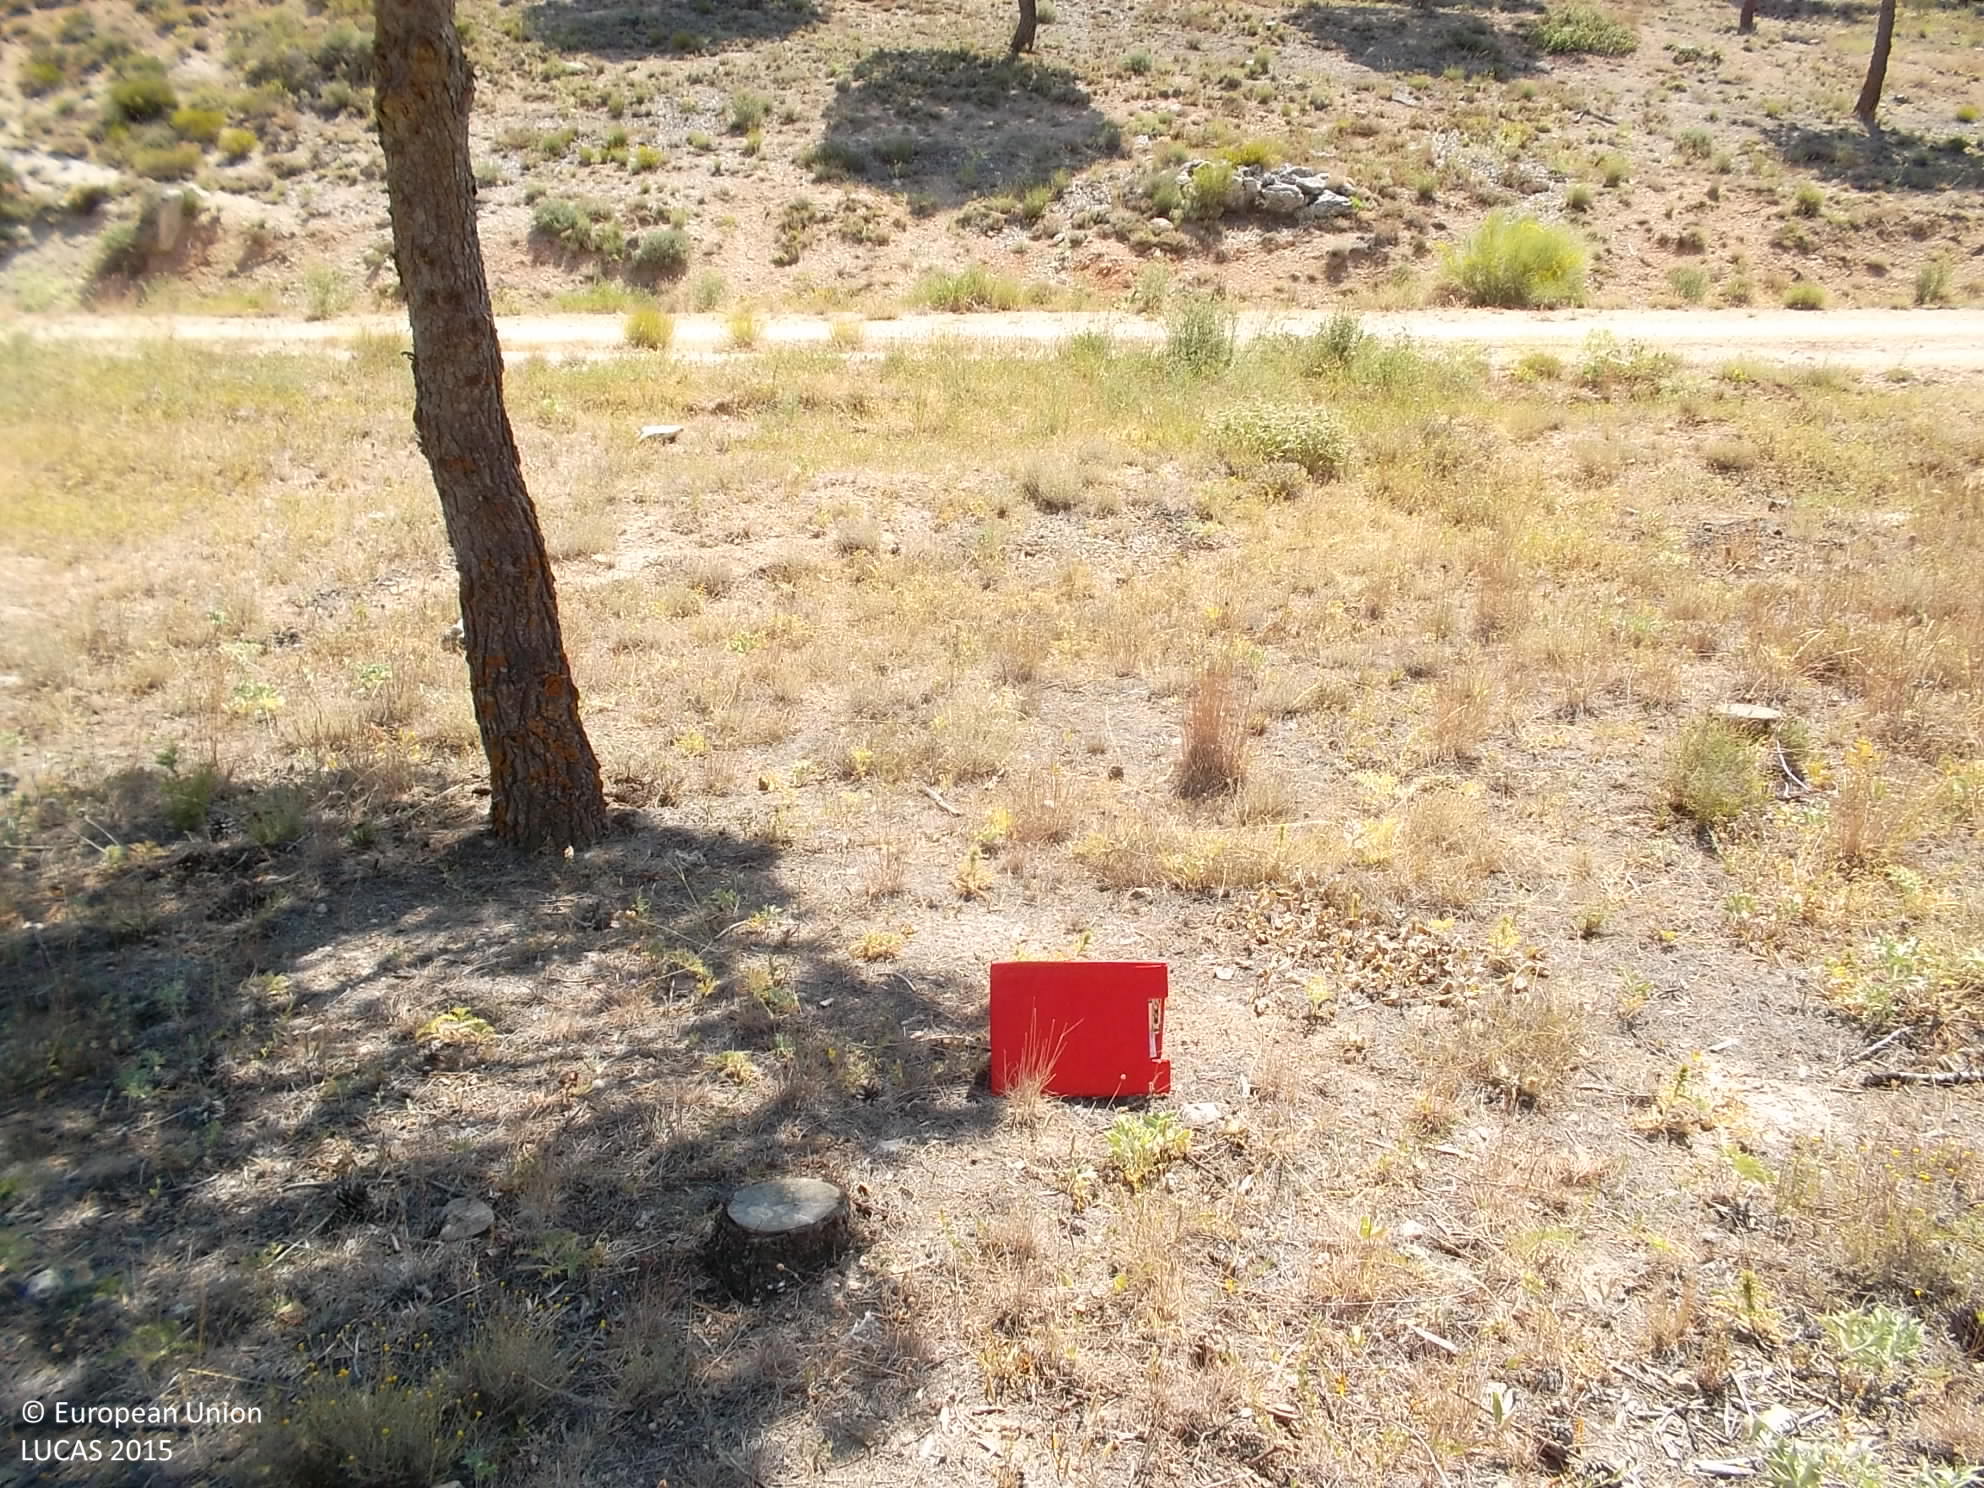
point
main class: Woodland
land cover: Pine dominated coniferous woodland
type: alpine coniferous forest
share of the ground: 25 - 50 %
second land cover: Spontaneously vegetated surfaces
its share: > 75 %
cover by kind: herbaceous plants 50 %, coniferous forest trees 30 %, unconsolidated bare surface 20 %
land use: Forestry
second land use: Agriculture (excluding fallow land and kitchen gardens)
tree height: > 5 m
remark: Clear cut
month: June
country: ES
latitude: 37.7048
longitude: -3.3225
